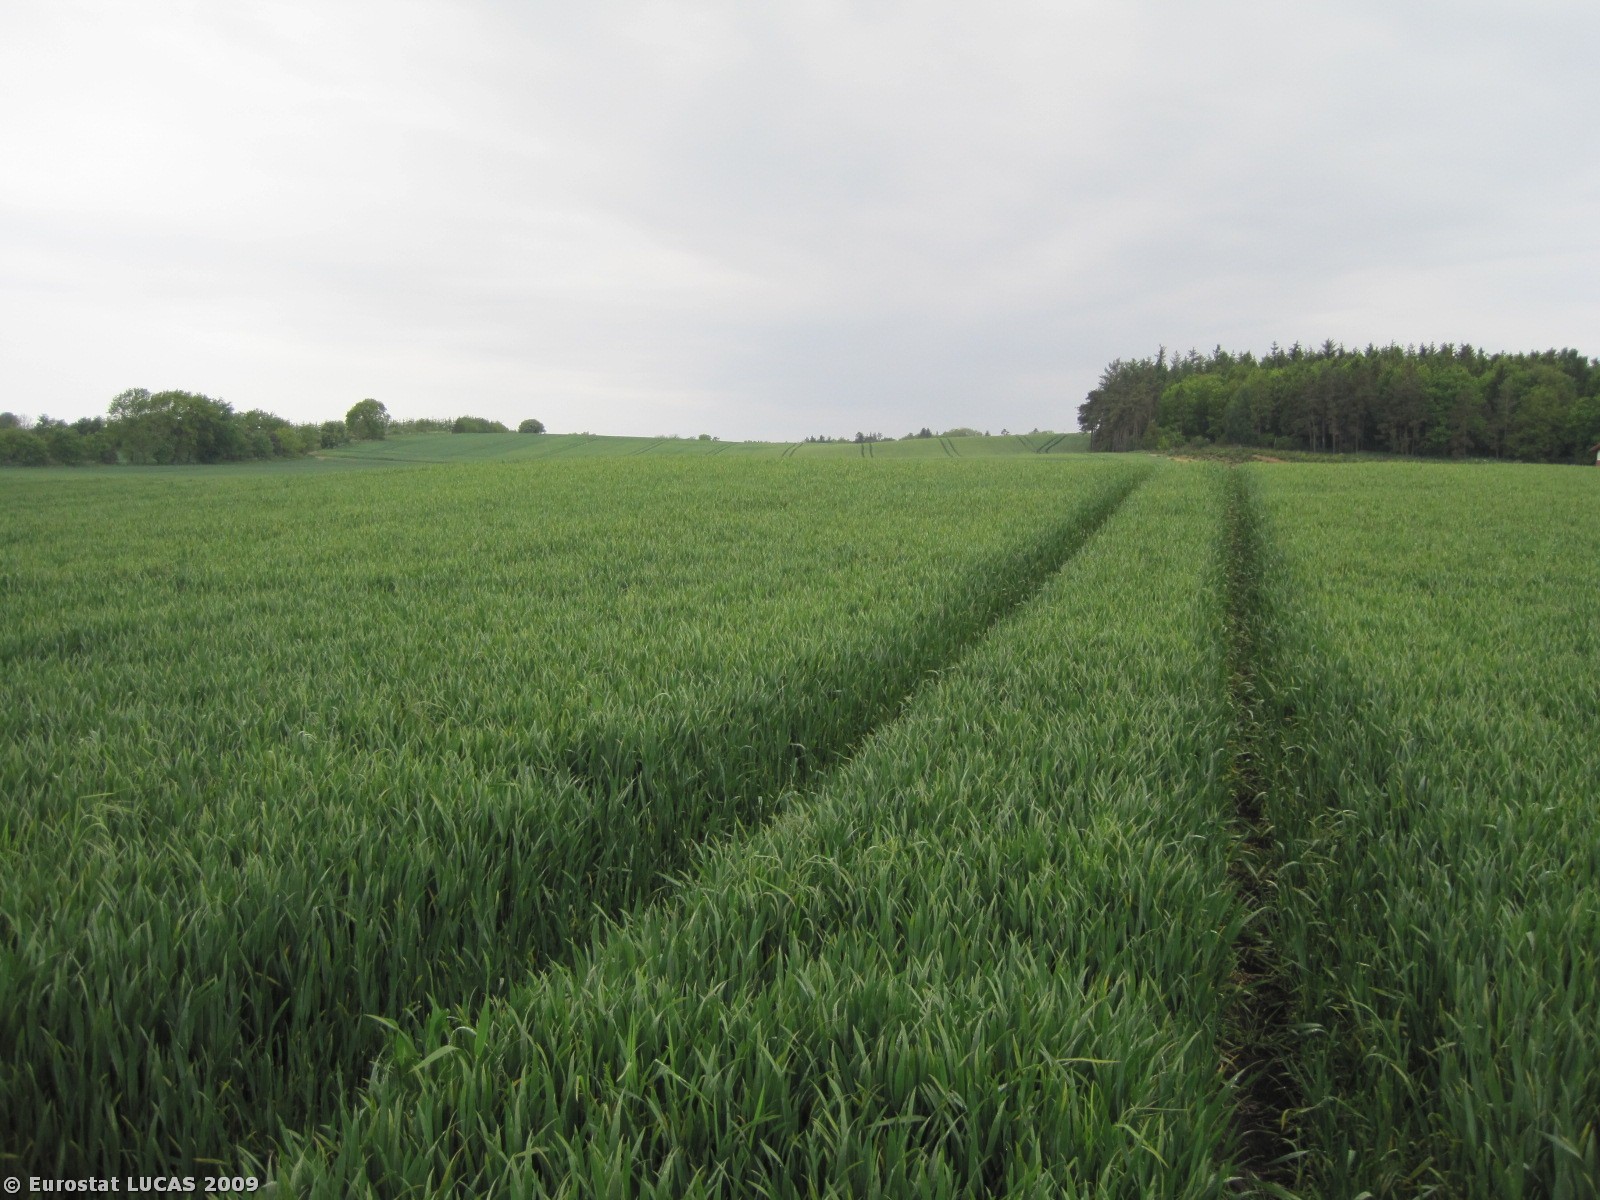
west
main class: Cropland
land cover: Common wheat
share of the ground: > 75 %
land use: Agriculture (excluding fallow land and kitchen gardens)
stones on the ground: < 10 %
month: May
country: DK
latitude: 56.7629
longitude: 10.1470
